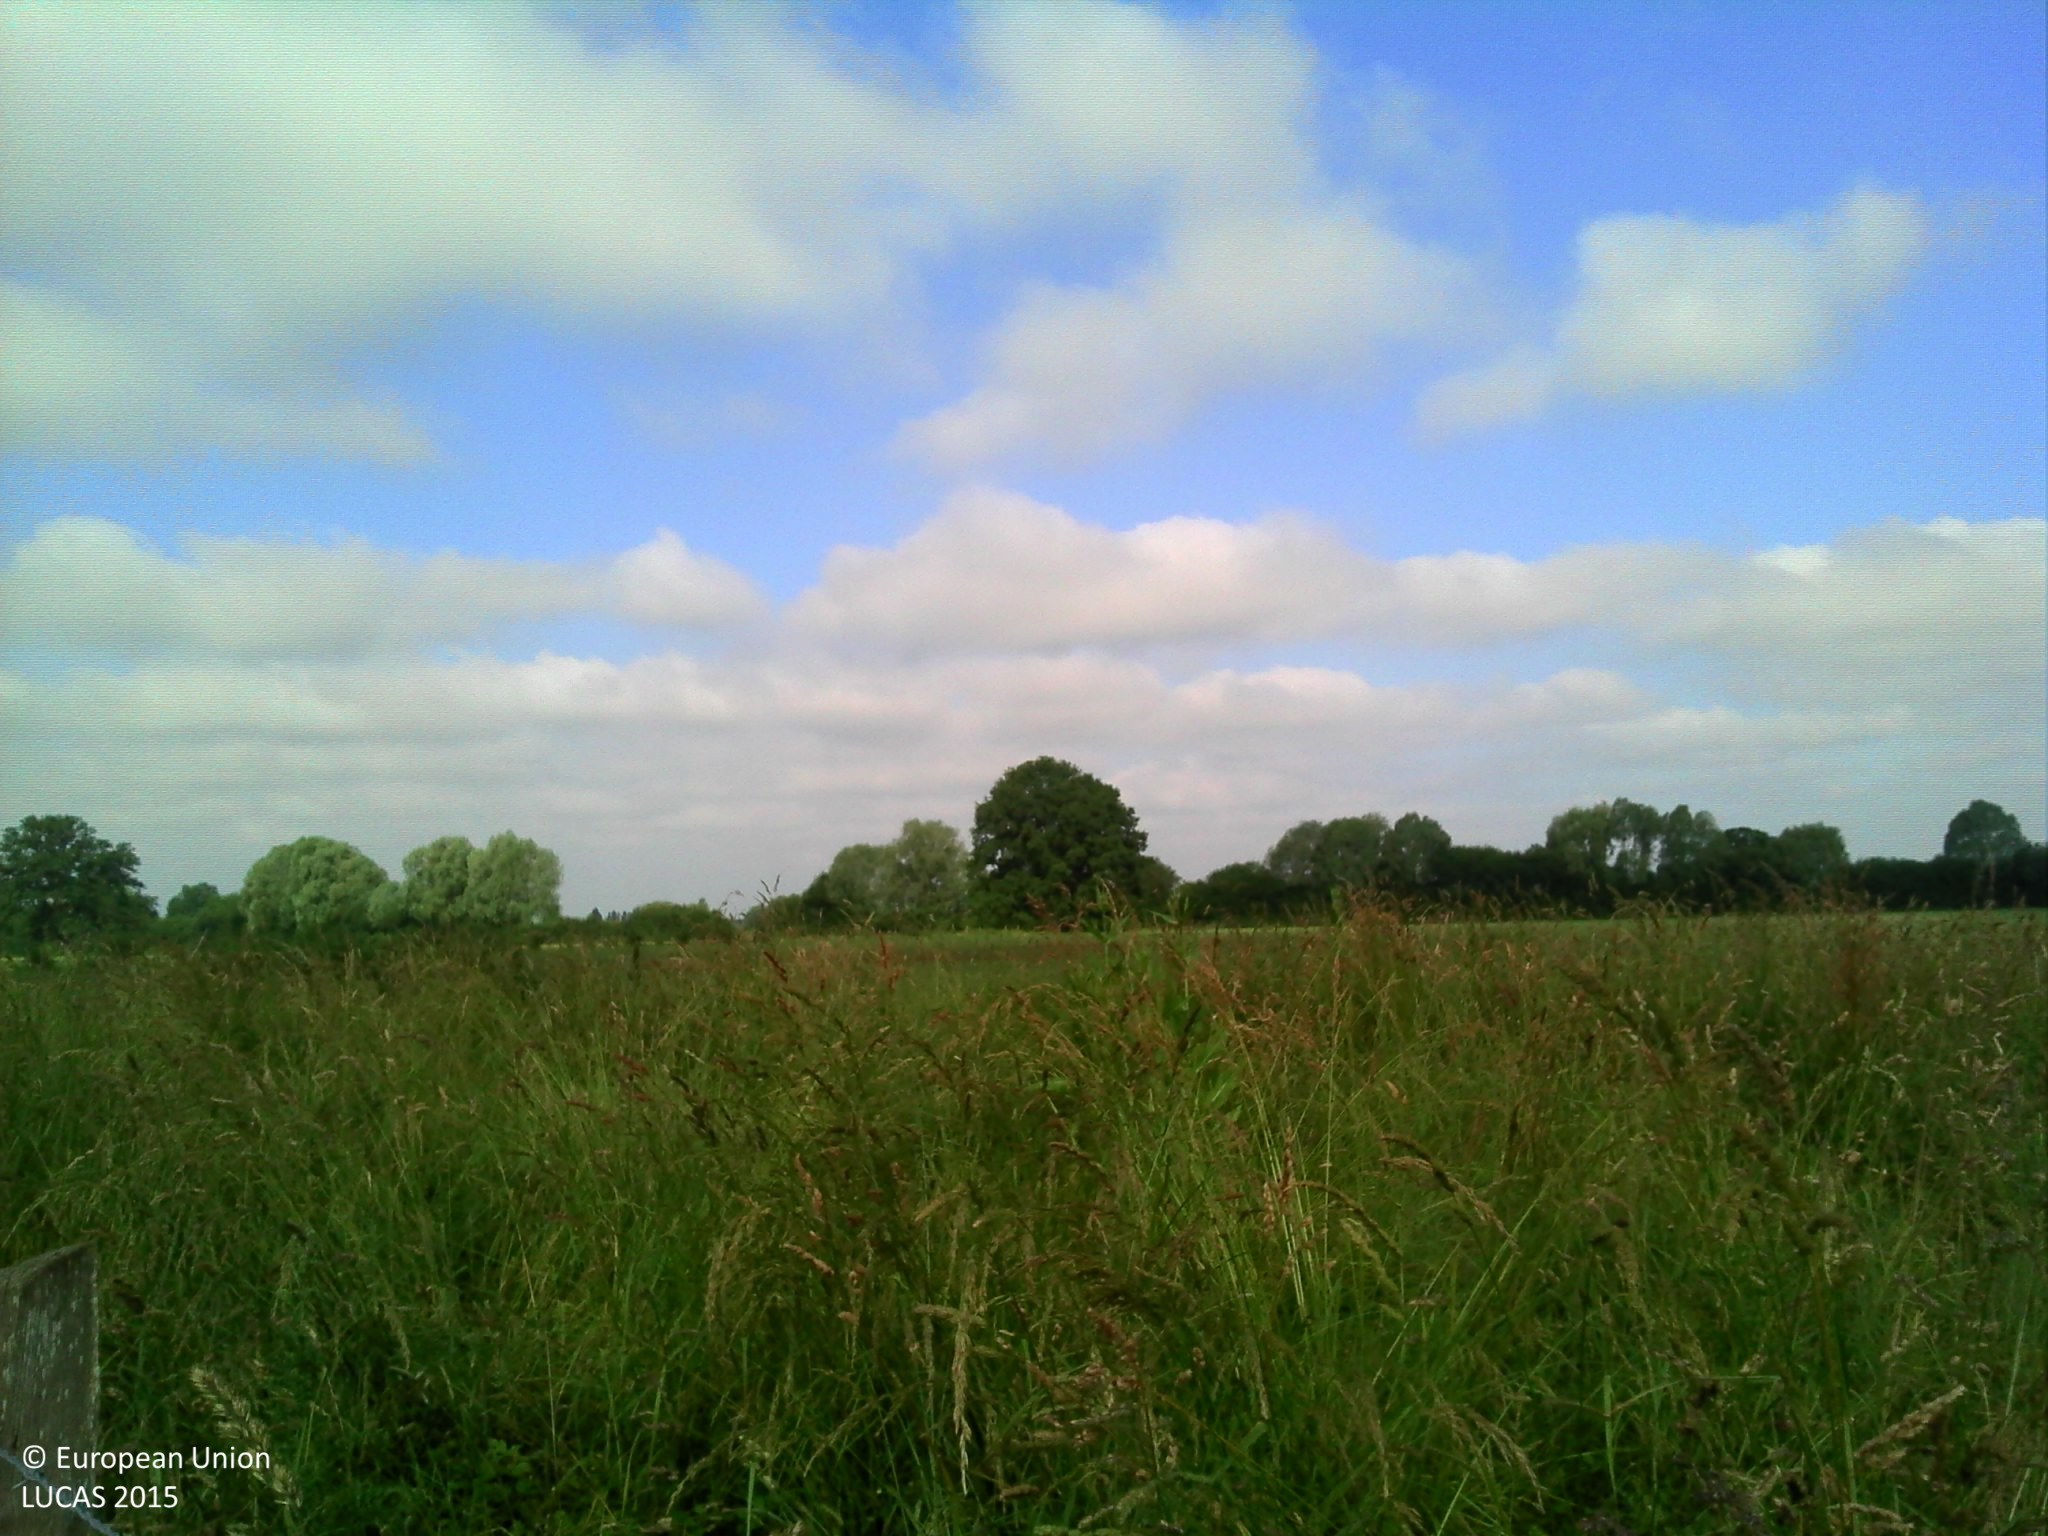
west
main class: Cropland
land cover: Maize
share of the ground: 25 - 50 %
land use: Agriculture (excluding fallow land and kitchen gardens)
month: June
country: FR
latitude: 48.1889
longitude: 0.2482
